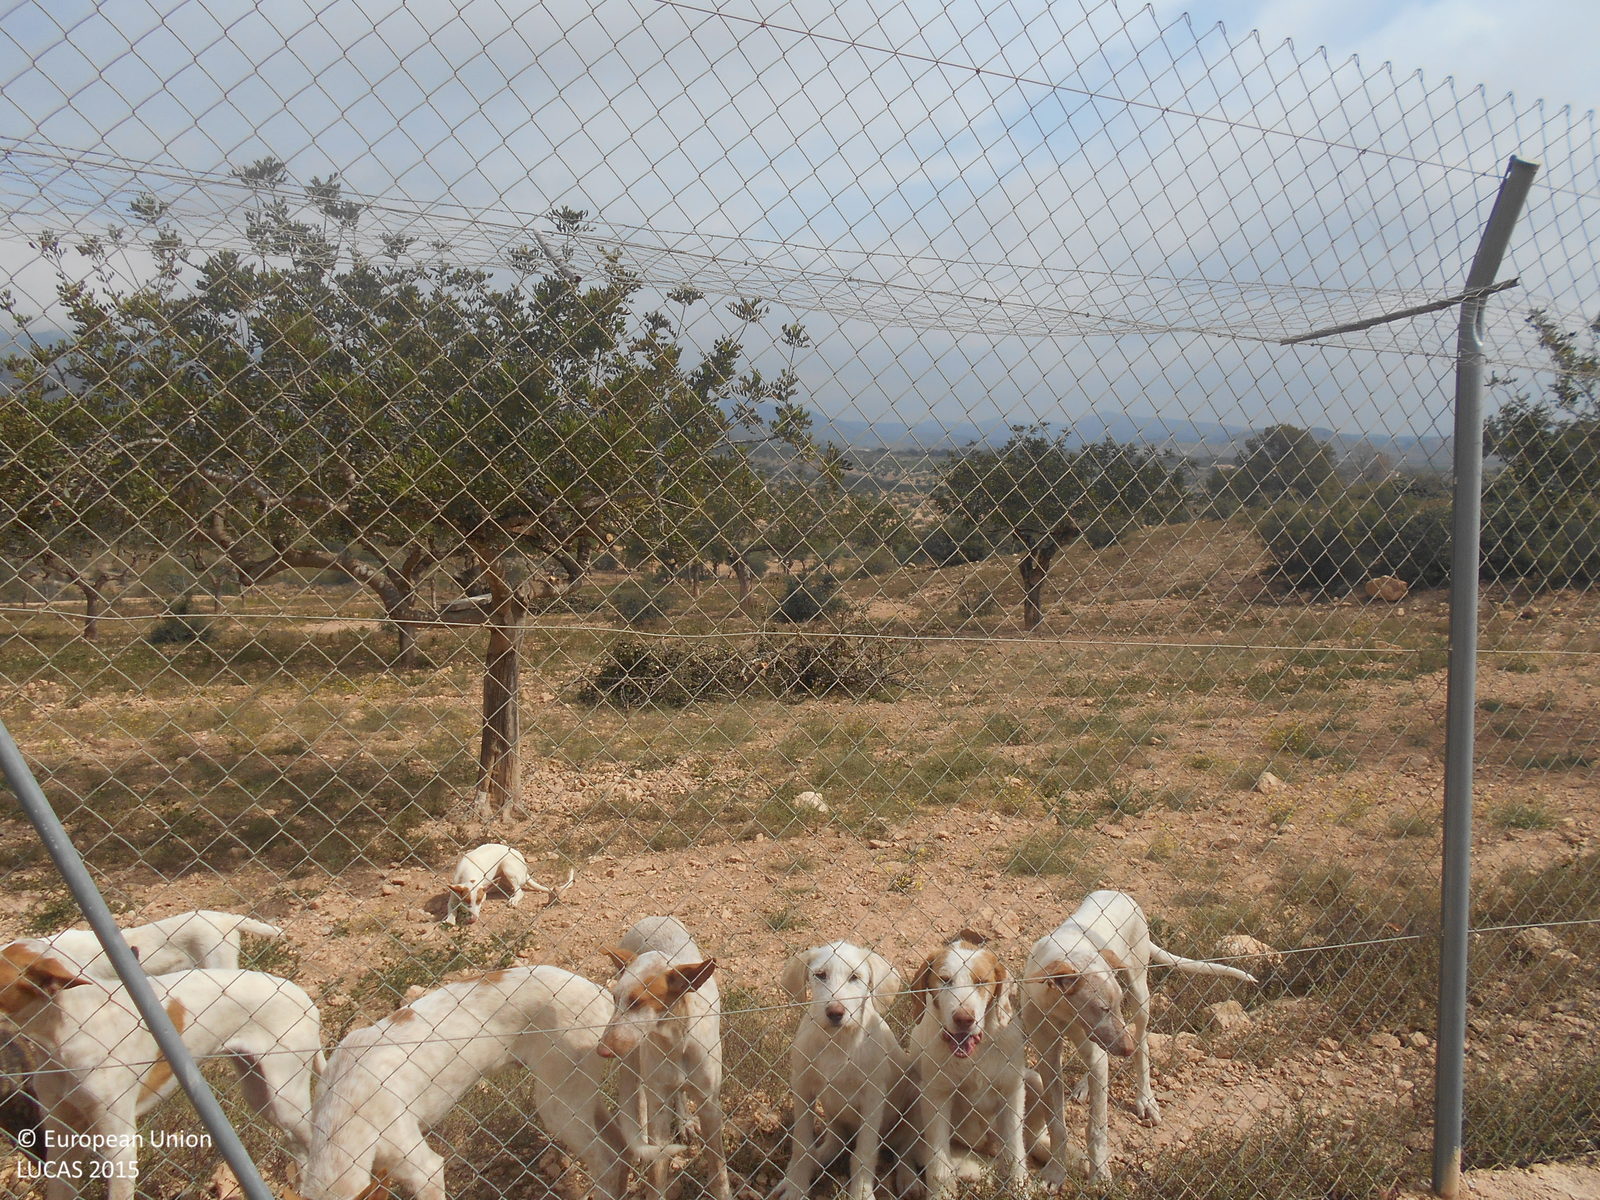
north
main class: Cropland
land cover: Nuts trees
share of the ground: 10 - 25 %
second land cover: Spontaneously vegetated surfaces
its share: 25 - 50 %
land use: Agriculture (excluding fallow land and kitchen gardens)
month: April
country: ES
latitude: 37.8108
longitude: -1.2387
